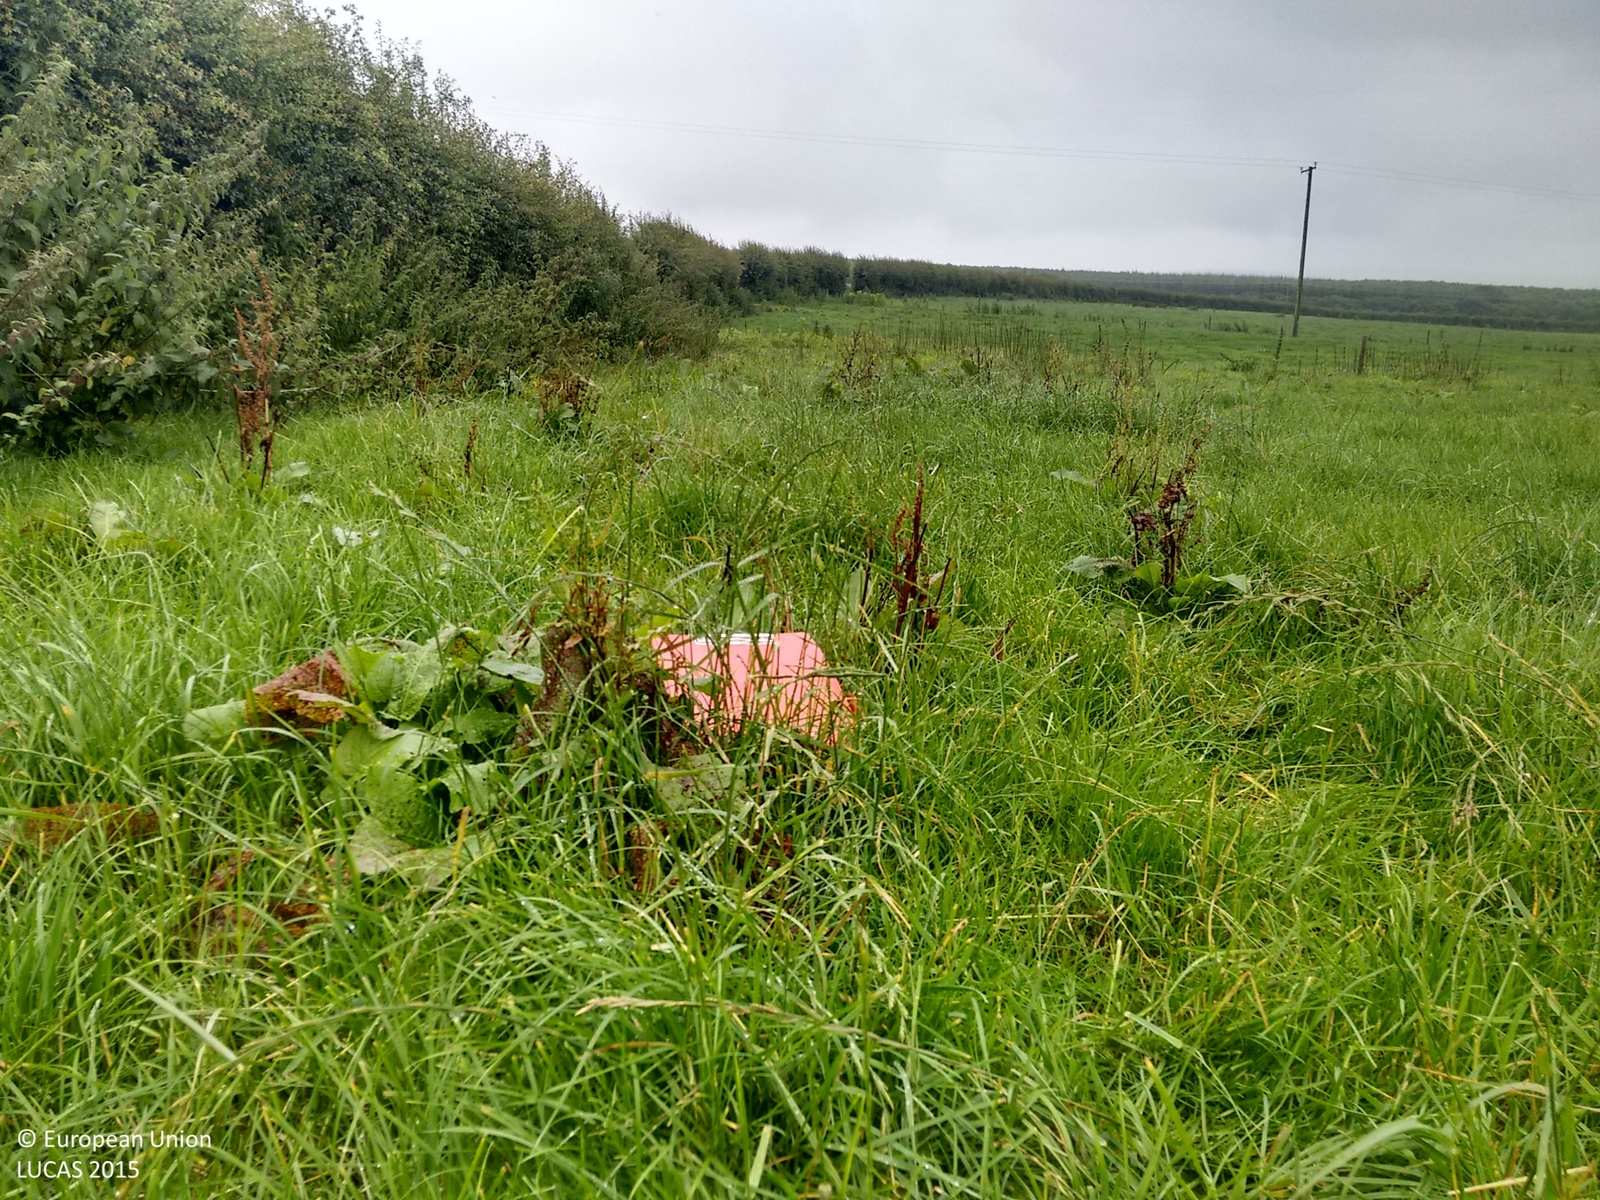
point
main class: Grassland
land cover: Grassland without tree/shrub cover
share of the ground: > 75 %
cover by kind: herbaceous plants 95 %, shrubs 5 %
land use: Agriculture (excluding fallow land and kitchen gardens)
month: August
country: IE
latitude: 52.2487
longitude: -9.4329
